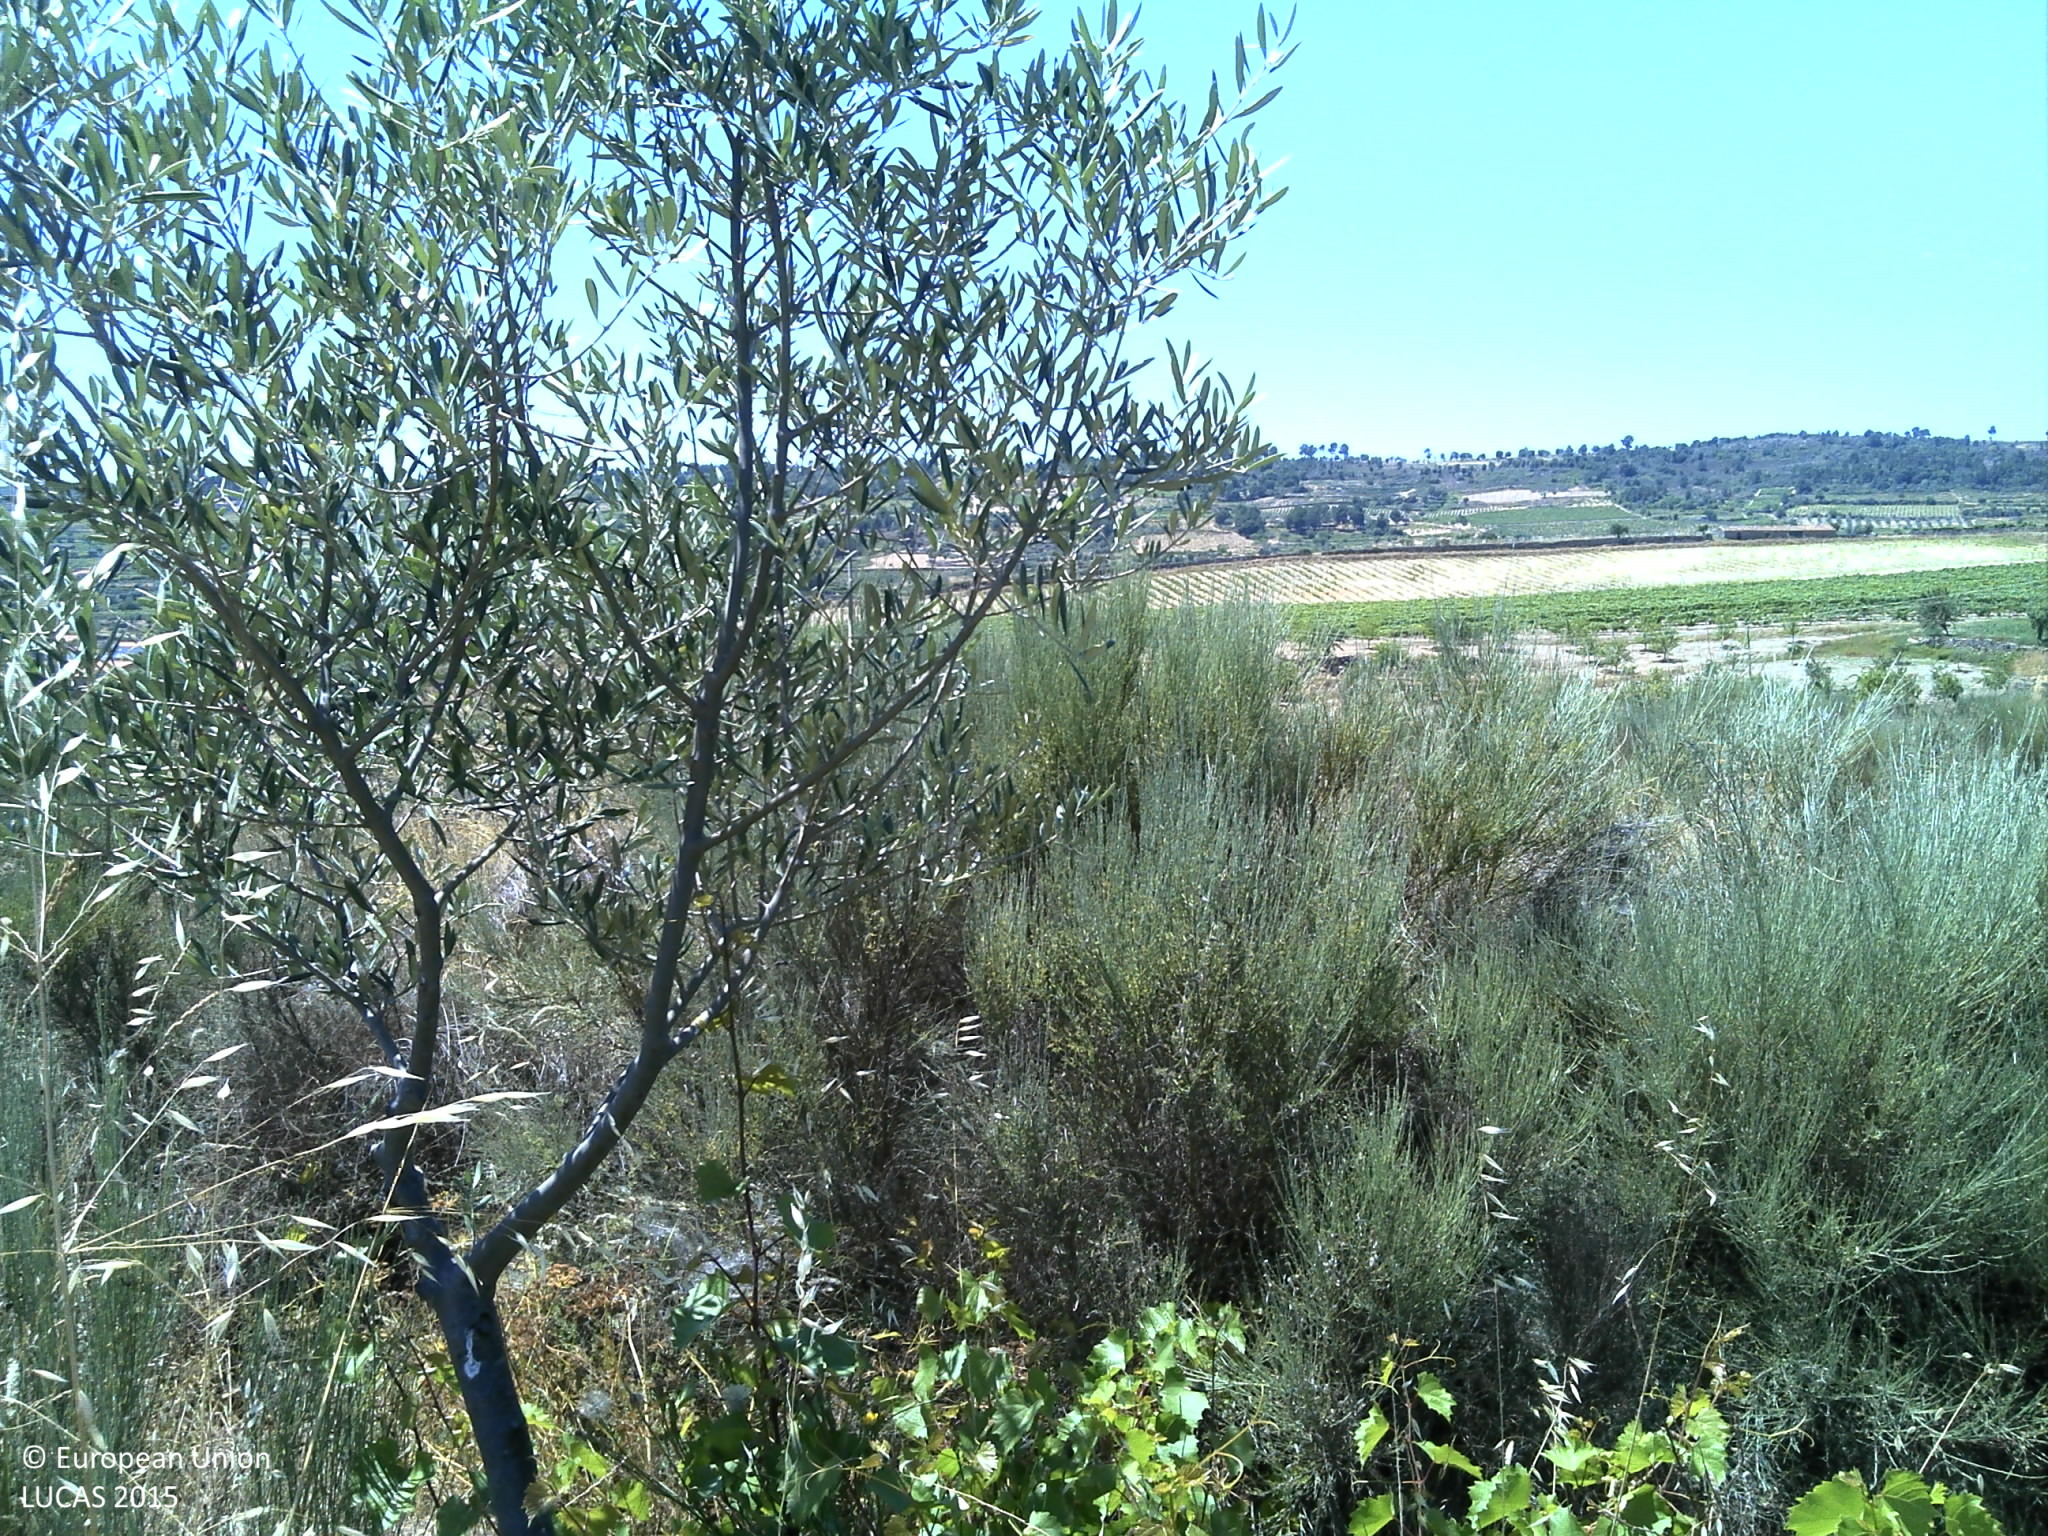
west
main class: Cropland
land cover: Olive groves
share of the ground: 10 - 25 %
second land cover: Grassland without tree/shrub cover
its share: 10 - 25 %
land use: Agriculture (excluding fallow land and kitchen gardens)
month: June
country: PT
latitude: 40.9177
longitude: -7.2697
